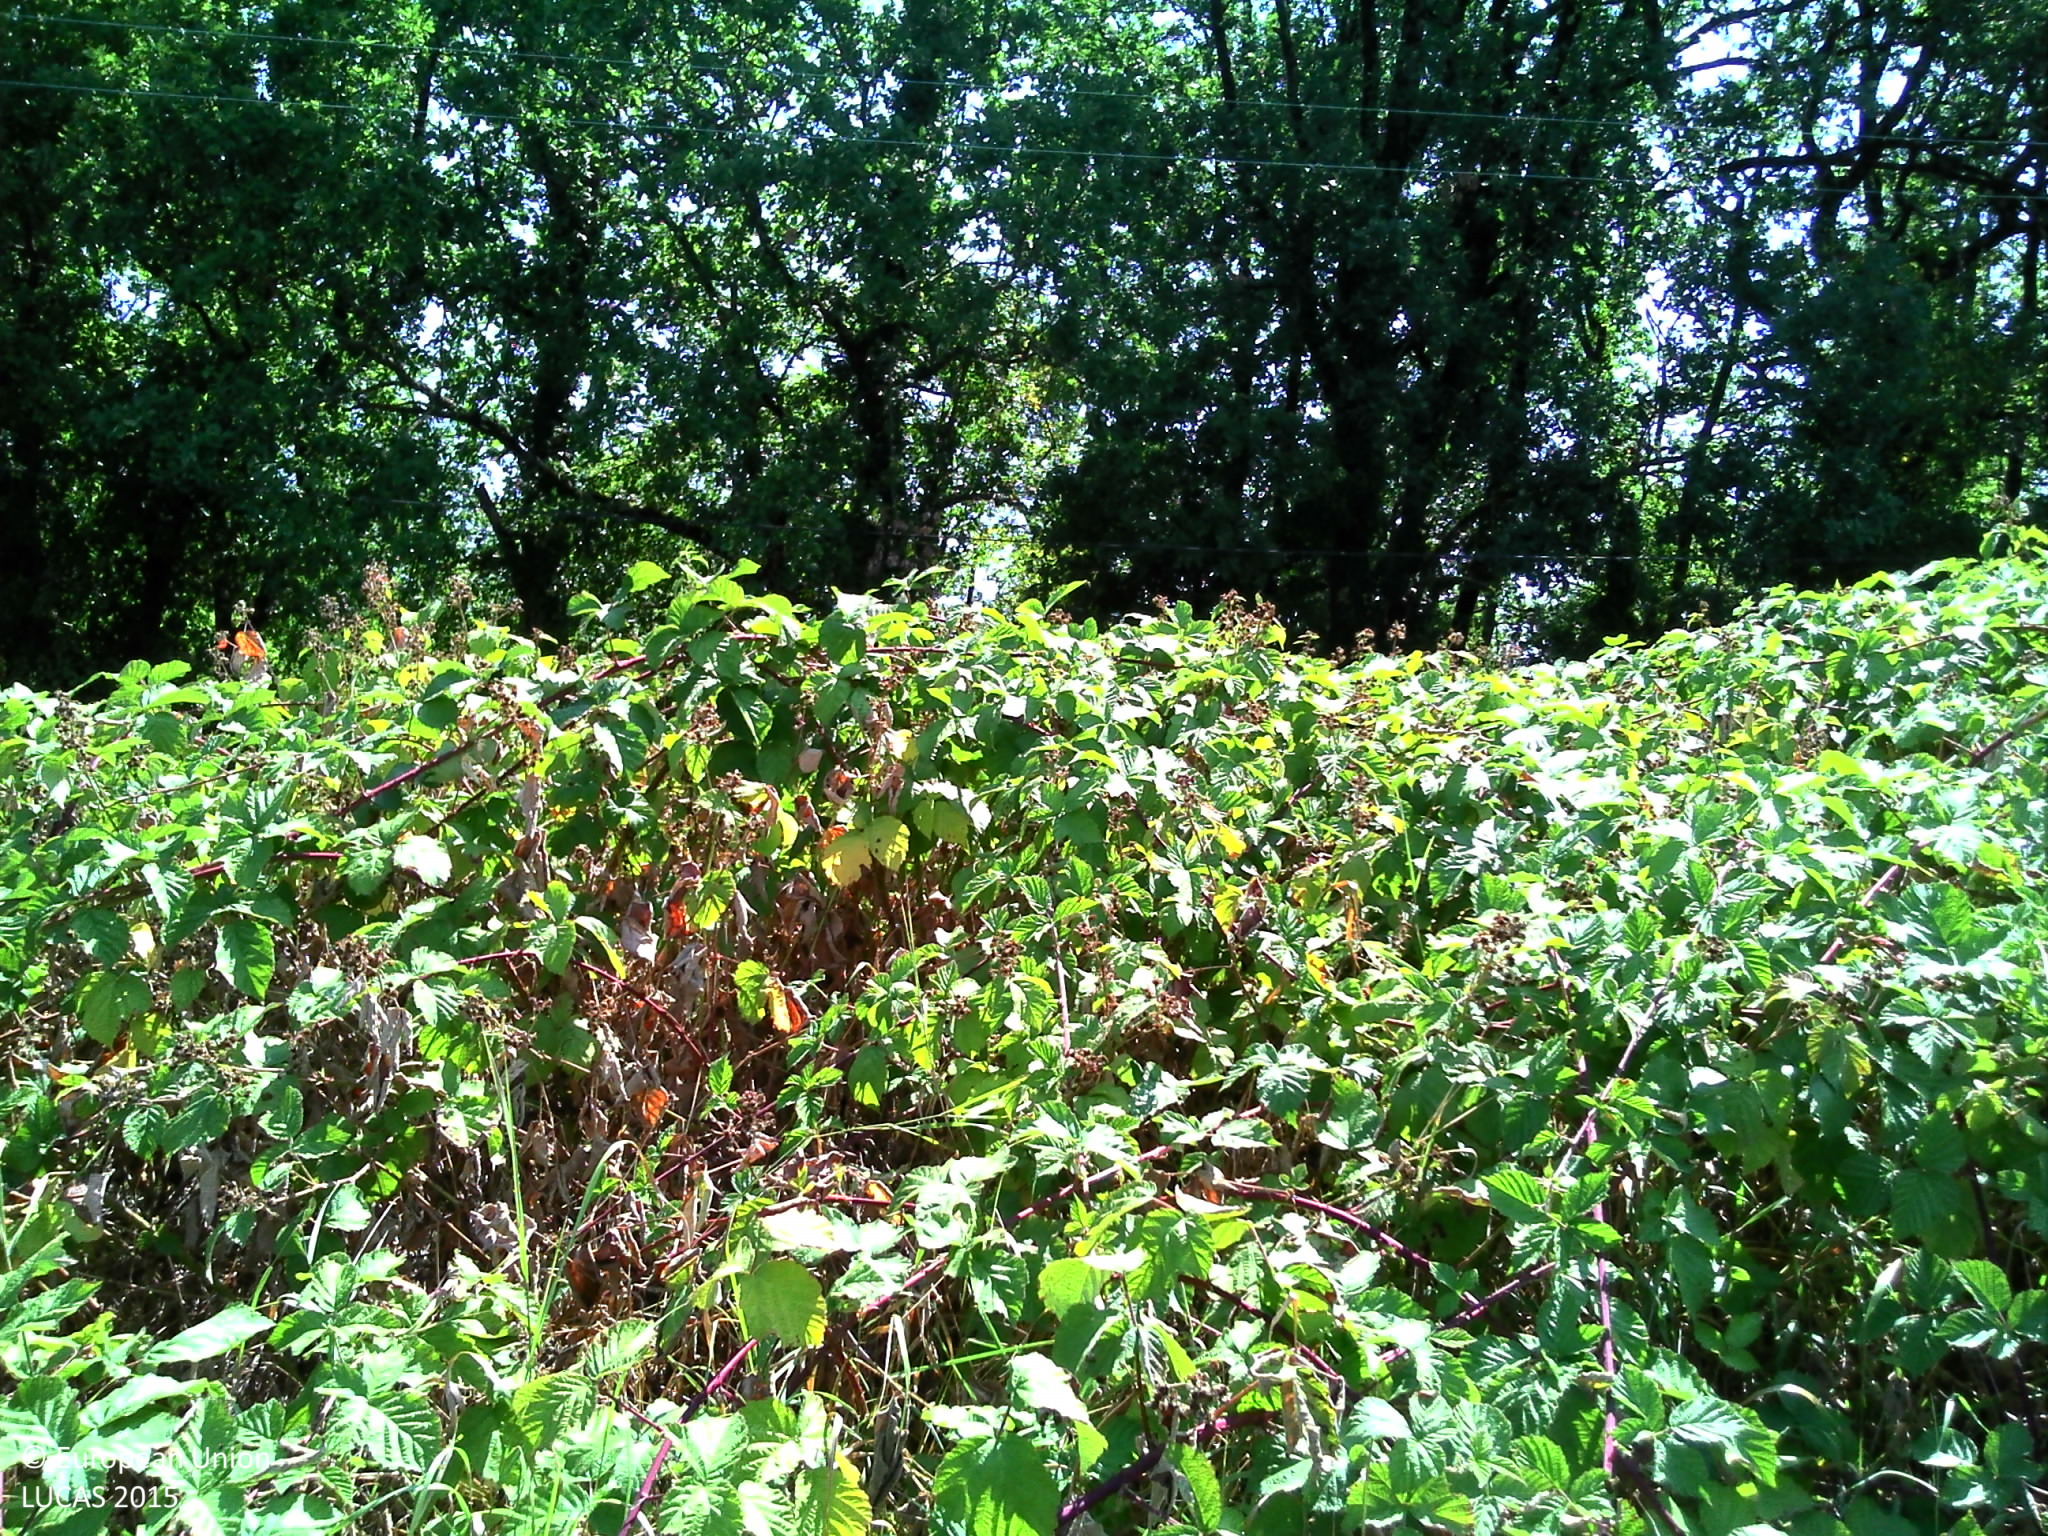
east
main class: Grassland
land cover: Spontaneously vegetated surfaces
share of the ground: > 75 %
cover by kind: herbaceous plants 100 %
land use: Fallow land
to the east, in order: Spontaneously vegetated surfaces; Fences; Electric lines; Paved roads, cycling and walking lanes; Broadleaved woodland; Spontaneously vegetated surfaces; Broadleaved woodland; Spontaneously vegetated surfaces
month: August
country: FR
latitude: 44.7403
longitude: 0.8117
